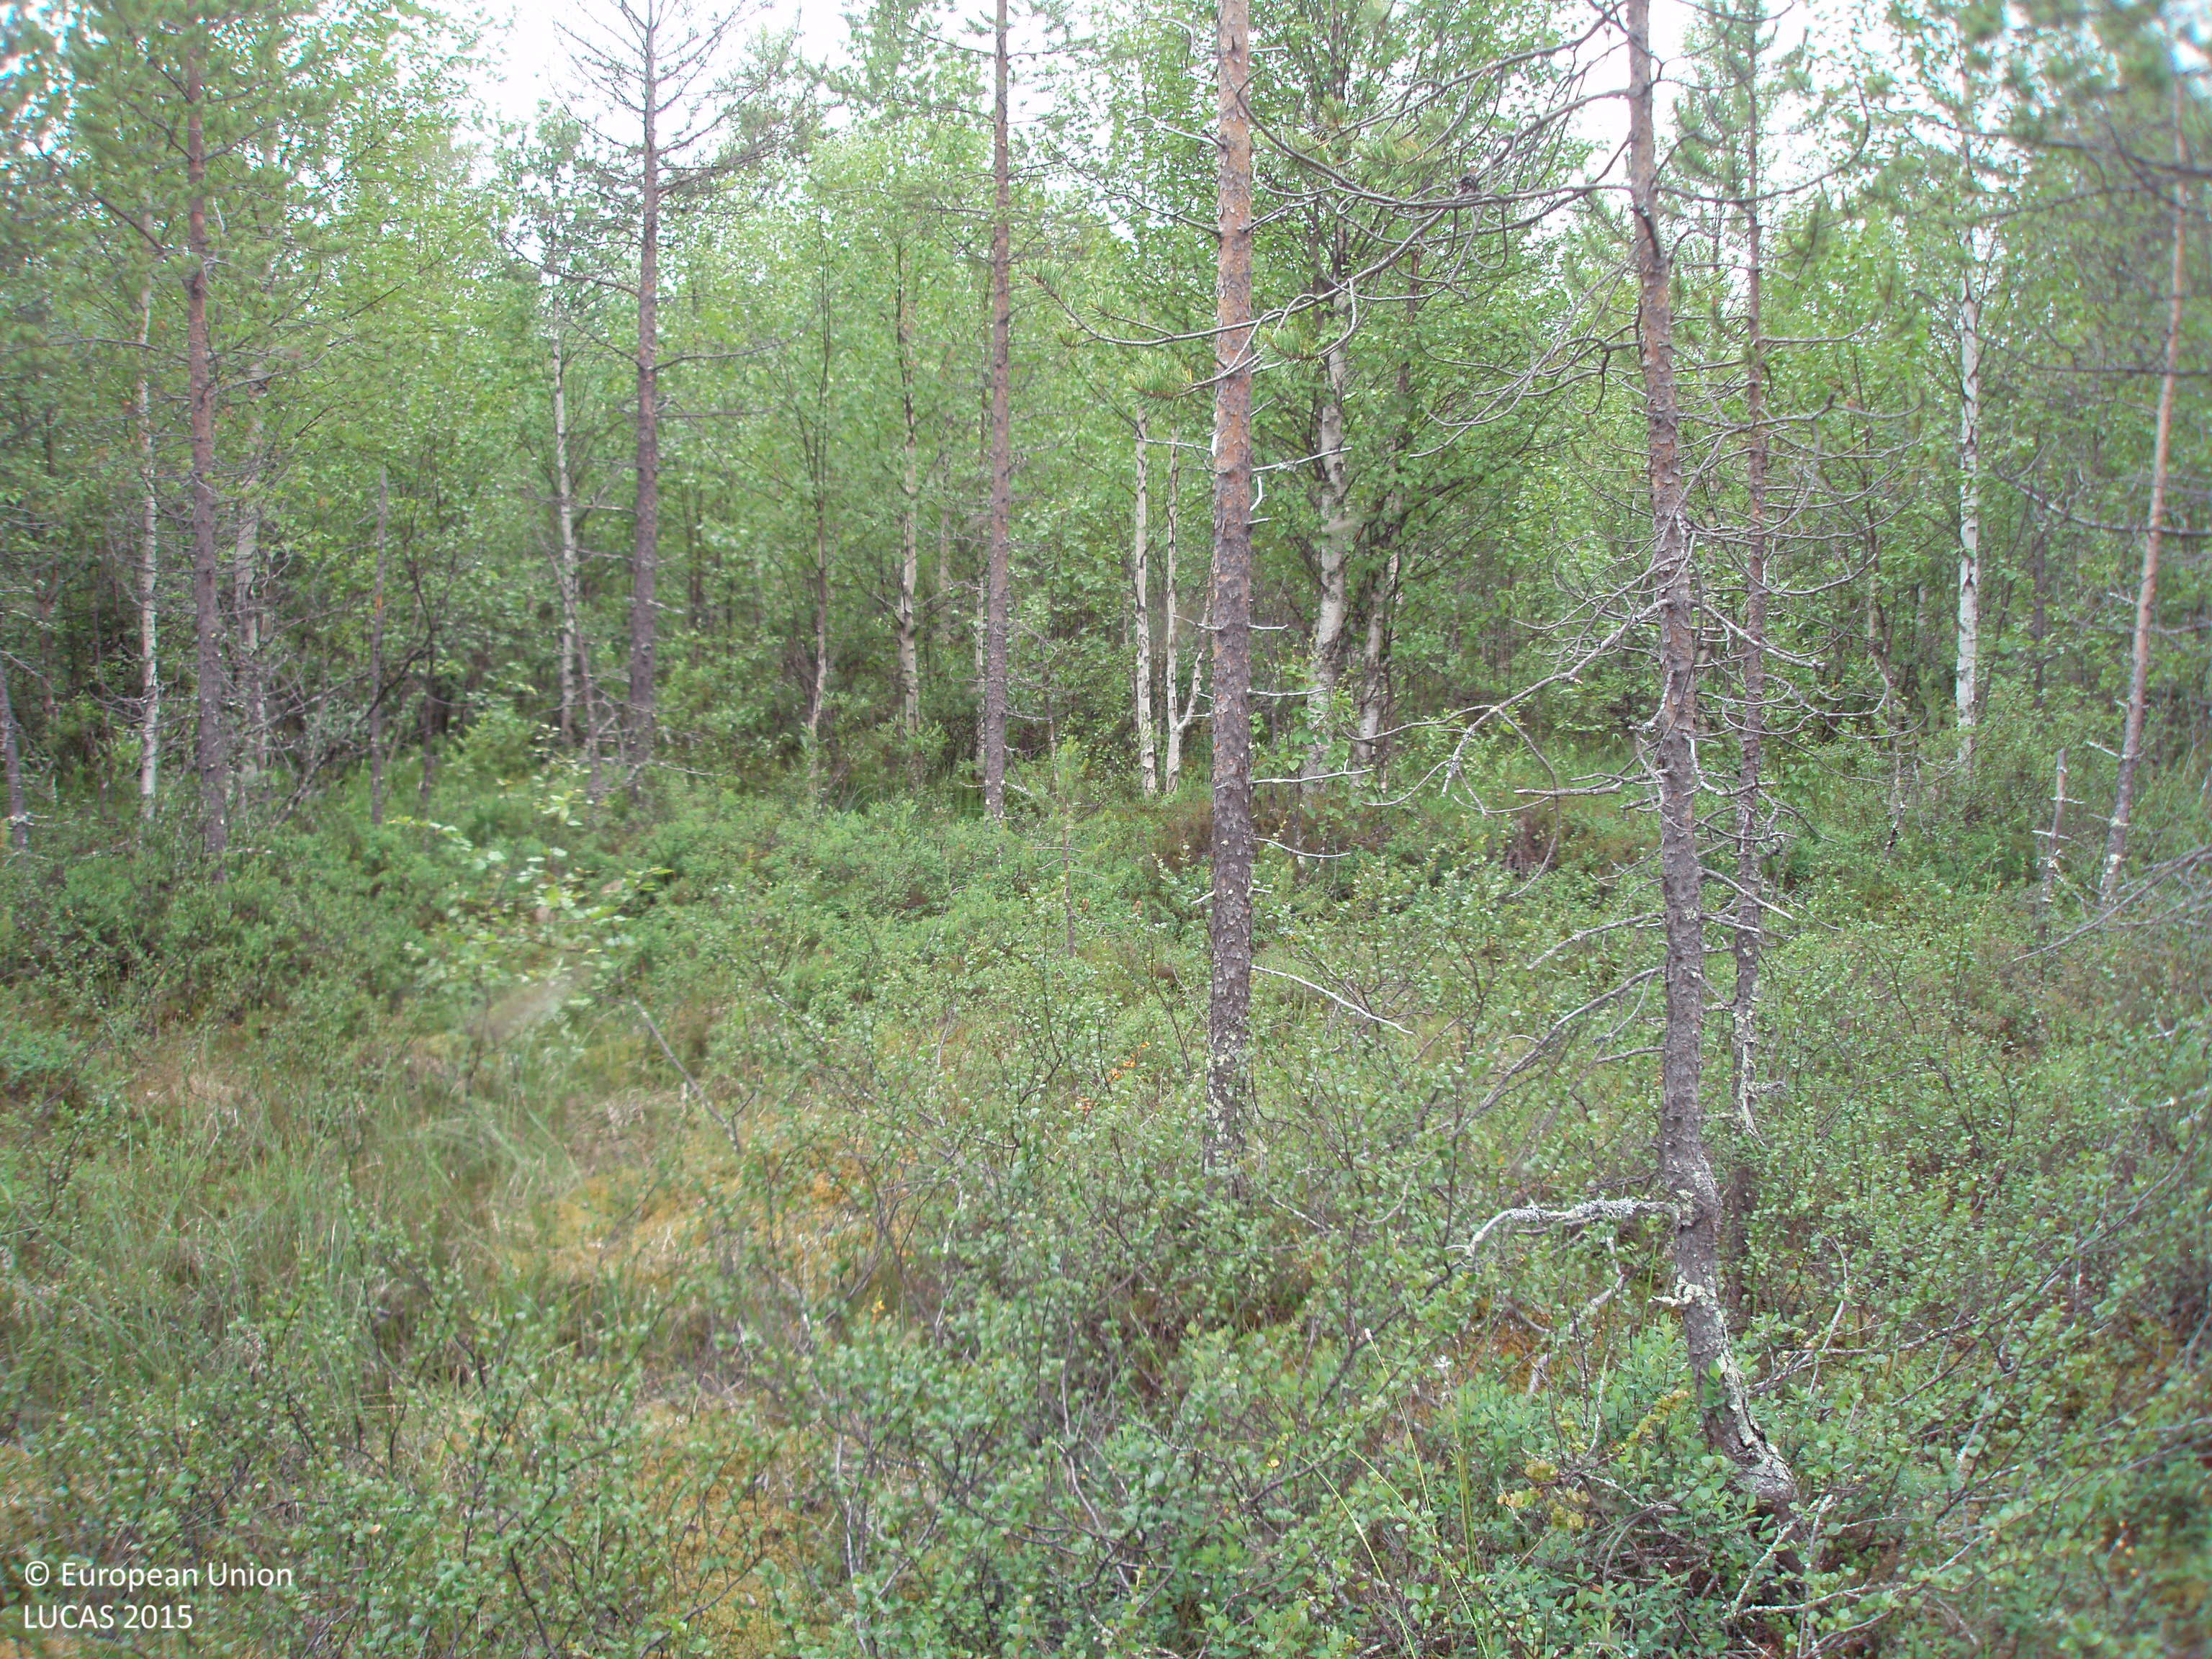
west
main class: Woodland
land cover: Pine dominated coniferous woodland
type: mire and swamp forests
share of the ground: 25 - 50 %
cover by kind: shrubs 45 %, coniferous forest trees 40 %, lichens and mosses 10 %, broadleaved forest trees 5 %
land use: Forestry
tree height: > 5 m
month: July
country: FI
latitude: 67.1963
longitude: 27.7040
